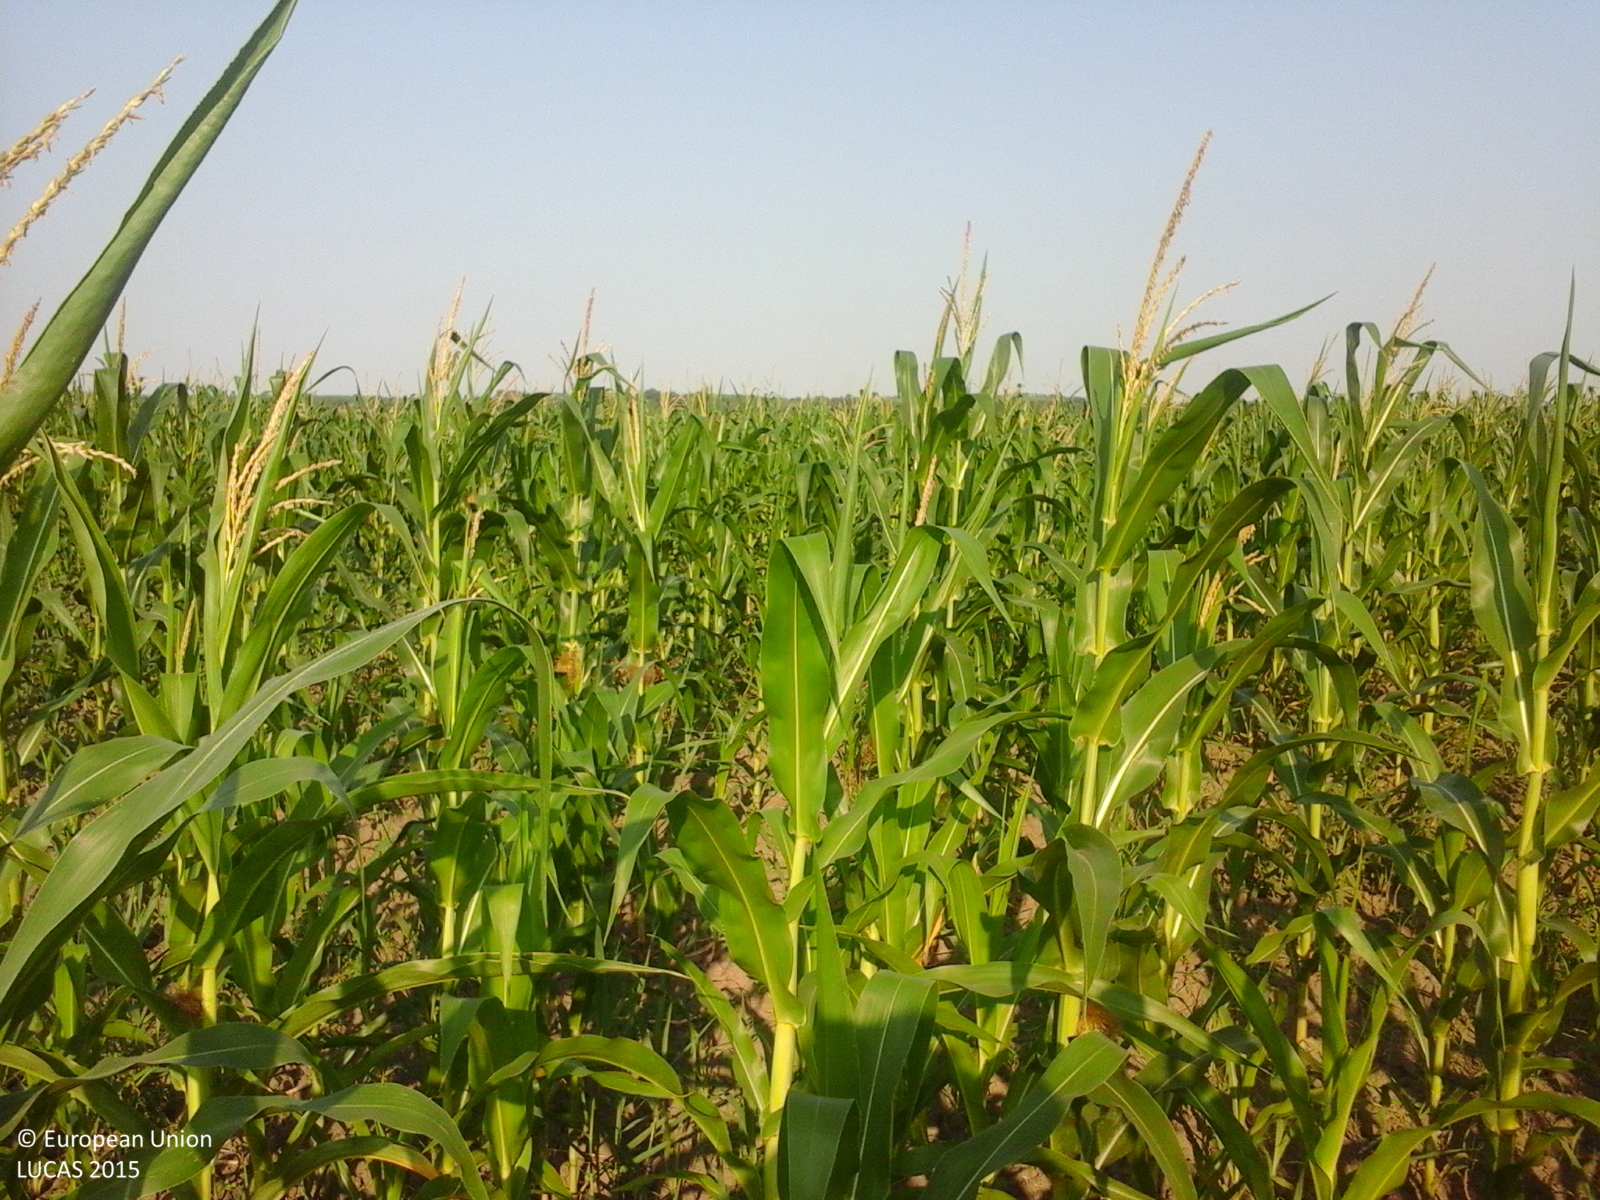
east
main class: Cropland
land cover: Maize
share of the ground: > 75 %
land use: Agriculture (excluding fallow land and kitchen gardens)
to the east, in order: Maize; Ditches and canals; Grass margins; Maize
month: July
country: RO
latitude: 44.6242
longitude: 26.7995
